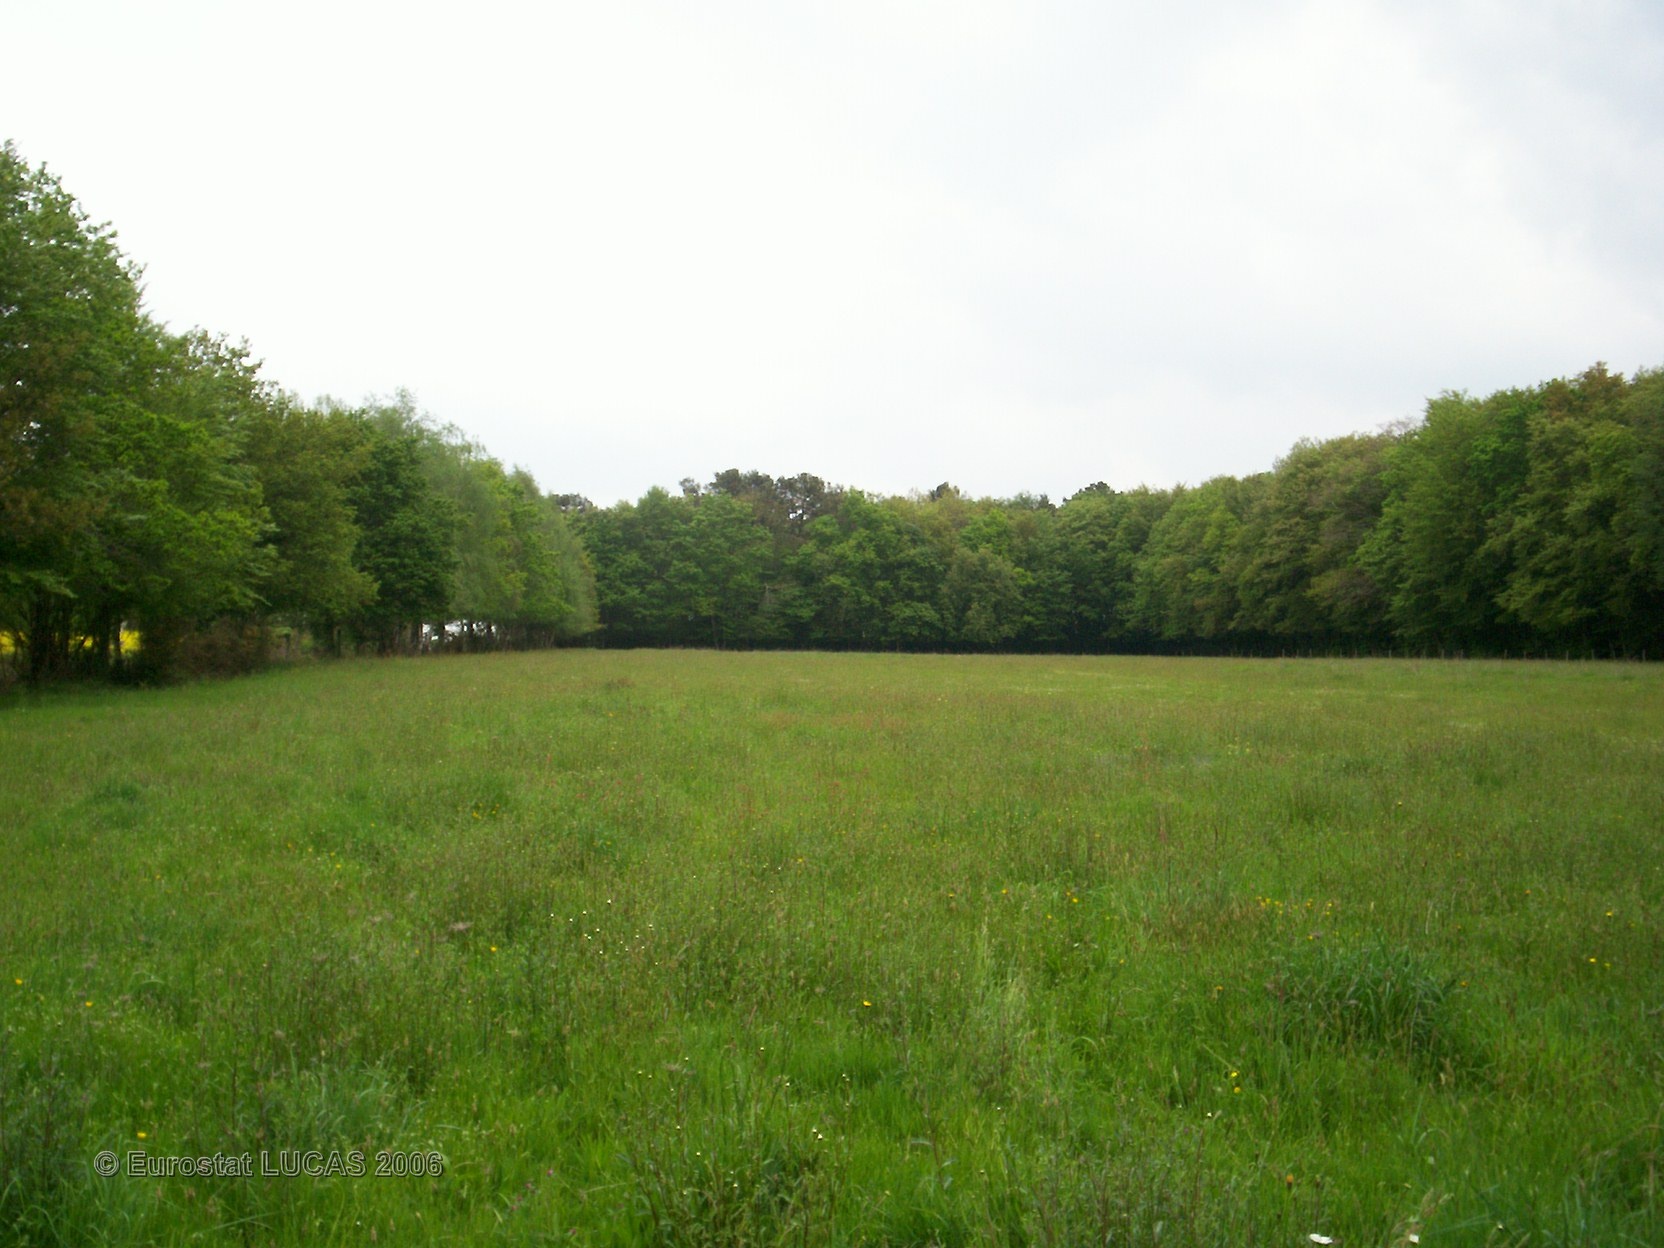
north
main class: Grassland
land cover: Grassland without tree/shrub cover
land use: Agriculture (excluding fallow land and kitchen gardens)
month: May
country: FR
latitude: 47.4917
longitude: -2.1704
